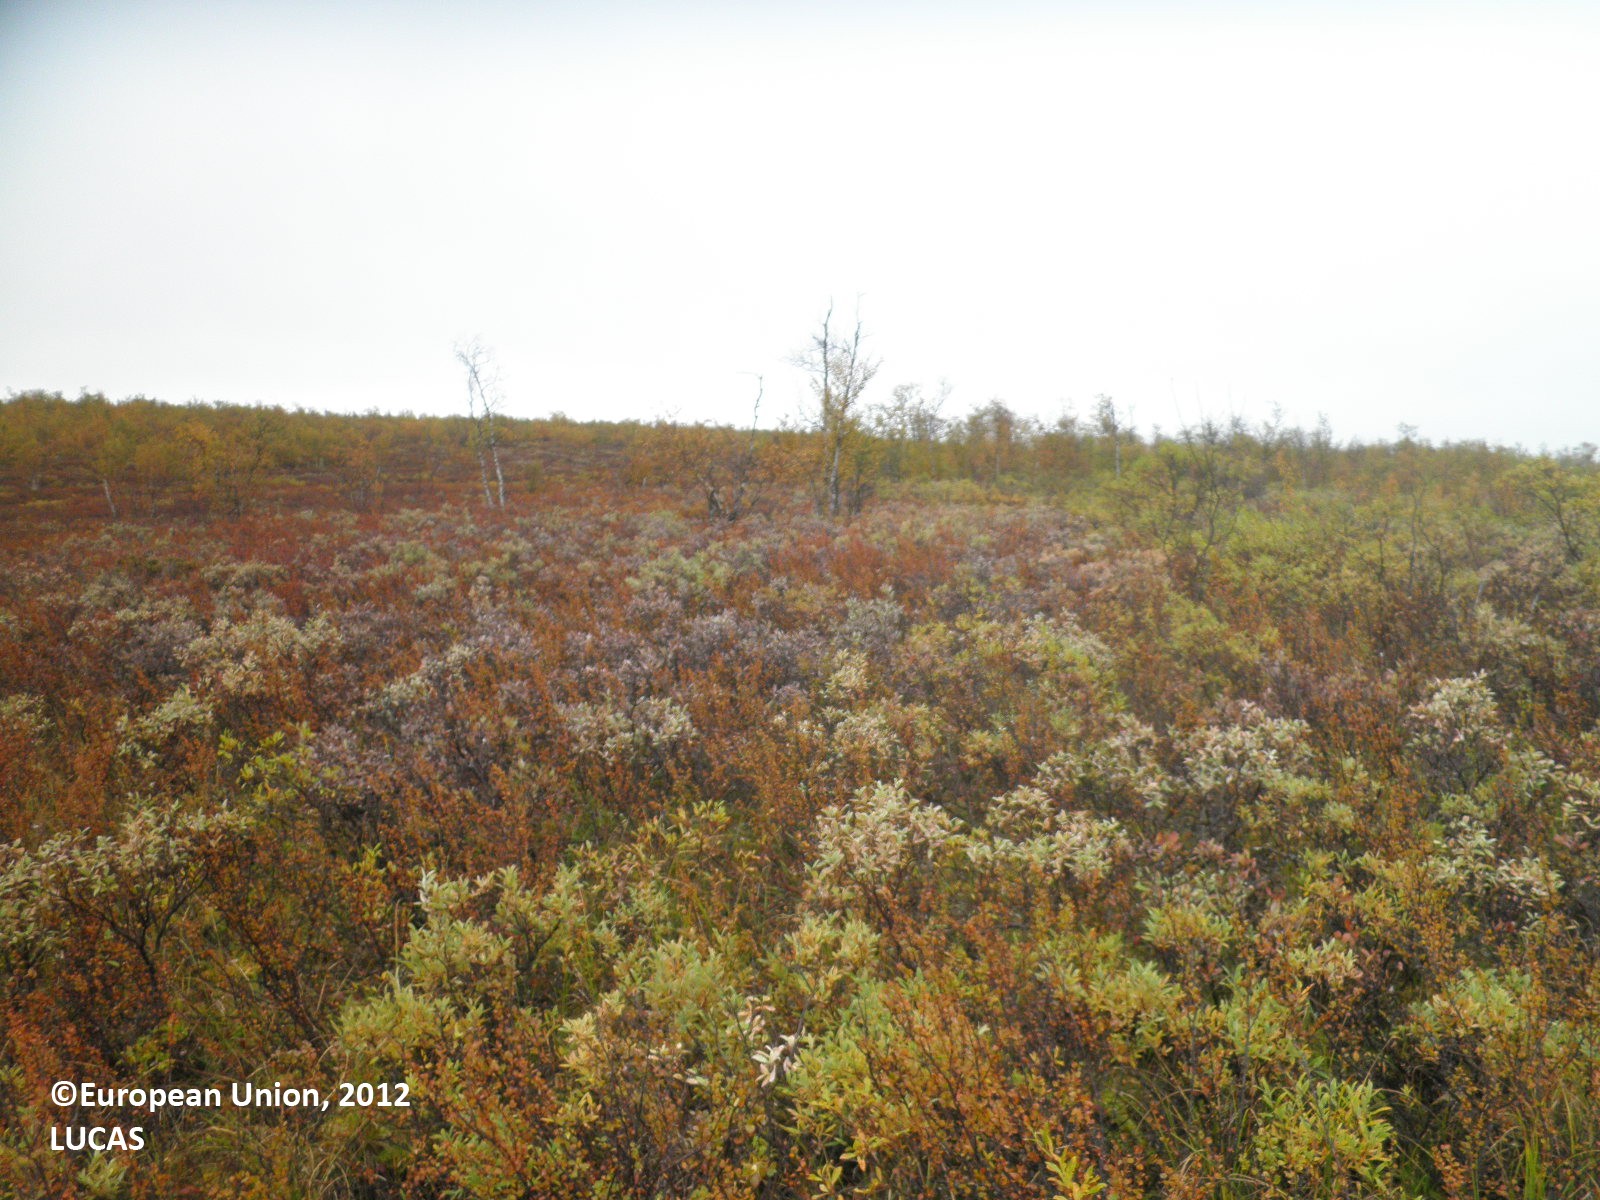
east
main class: Shrubland
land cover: Shrubland without tree cover
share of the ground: > 75 %
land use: Semi-natural and natural areas not in use
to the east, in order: Shrubland without tree cover; Shrubland with sparse tree cover; Shrubland without tree cover; Broadleaved woodland
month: September
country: FI
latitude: 68.8188
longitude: 21.2137
